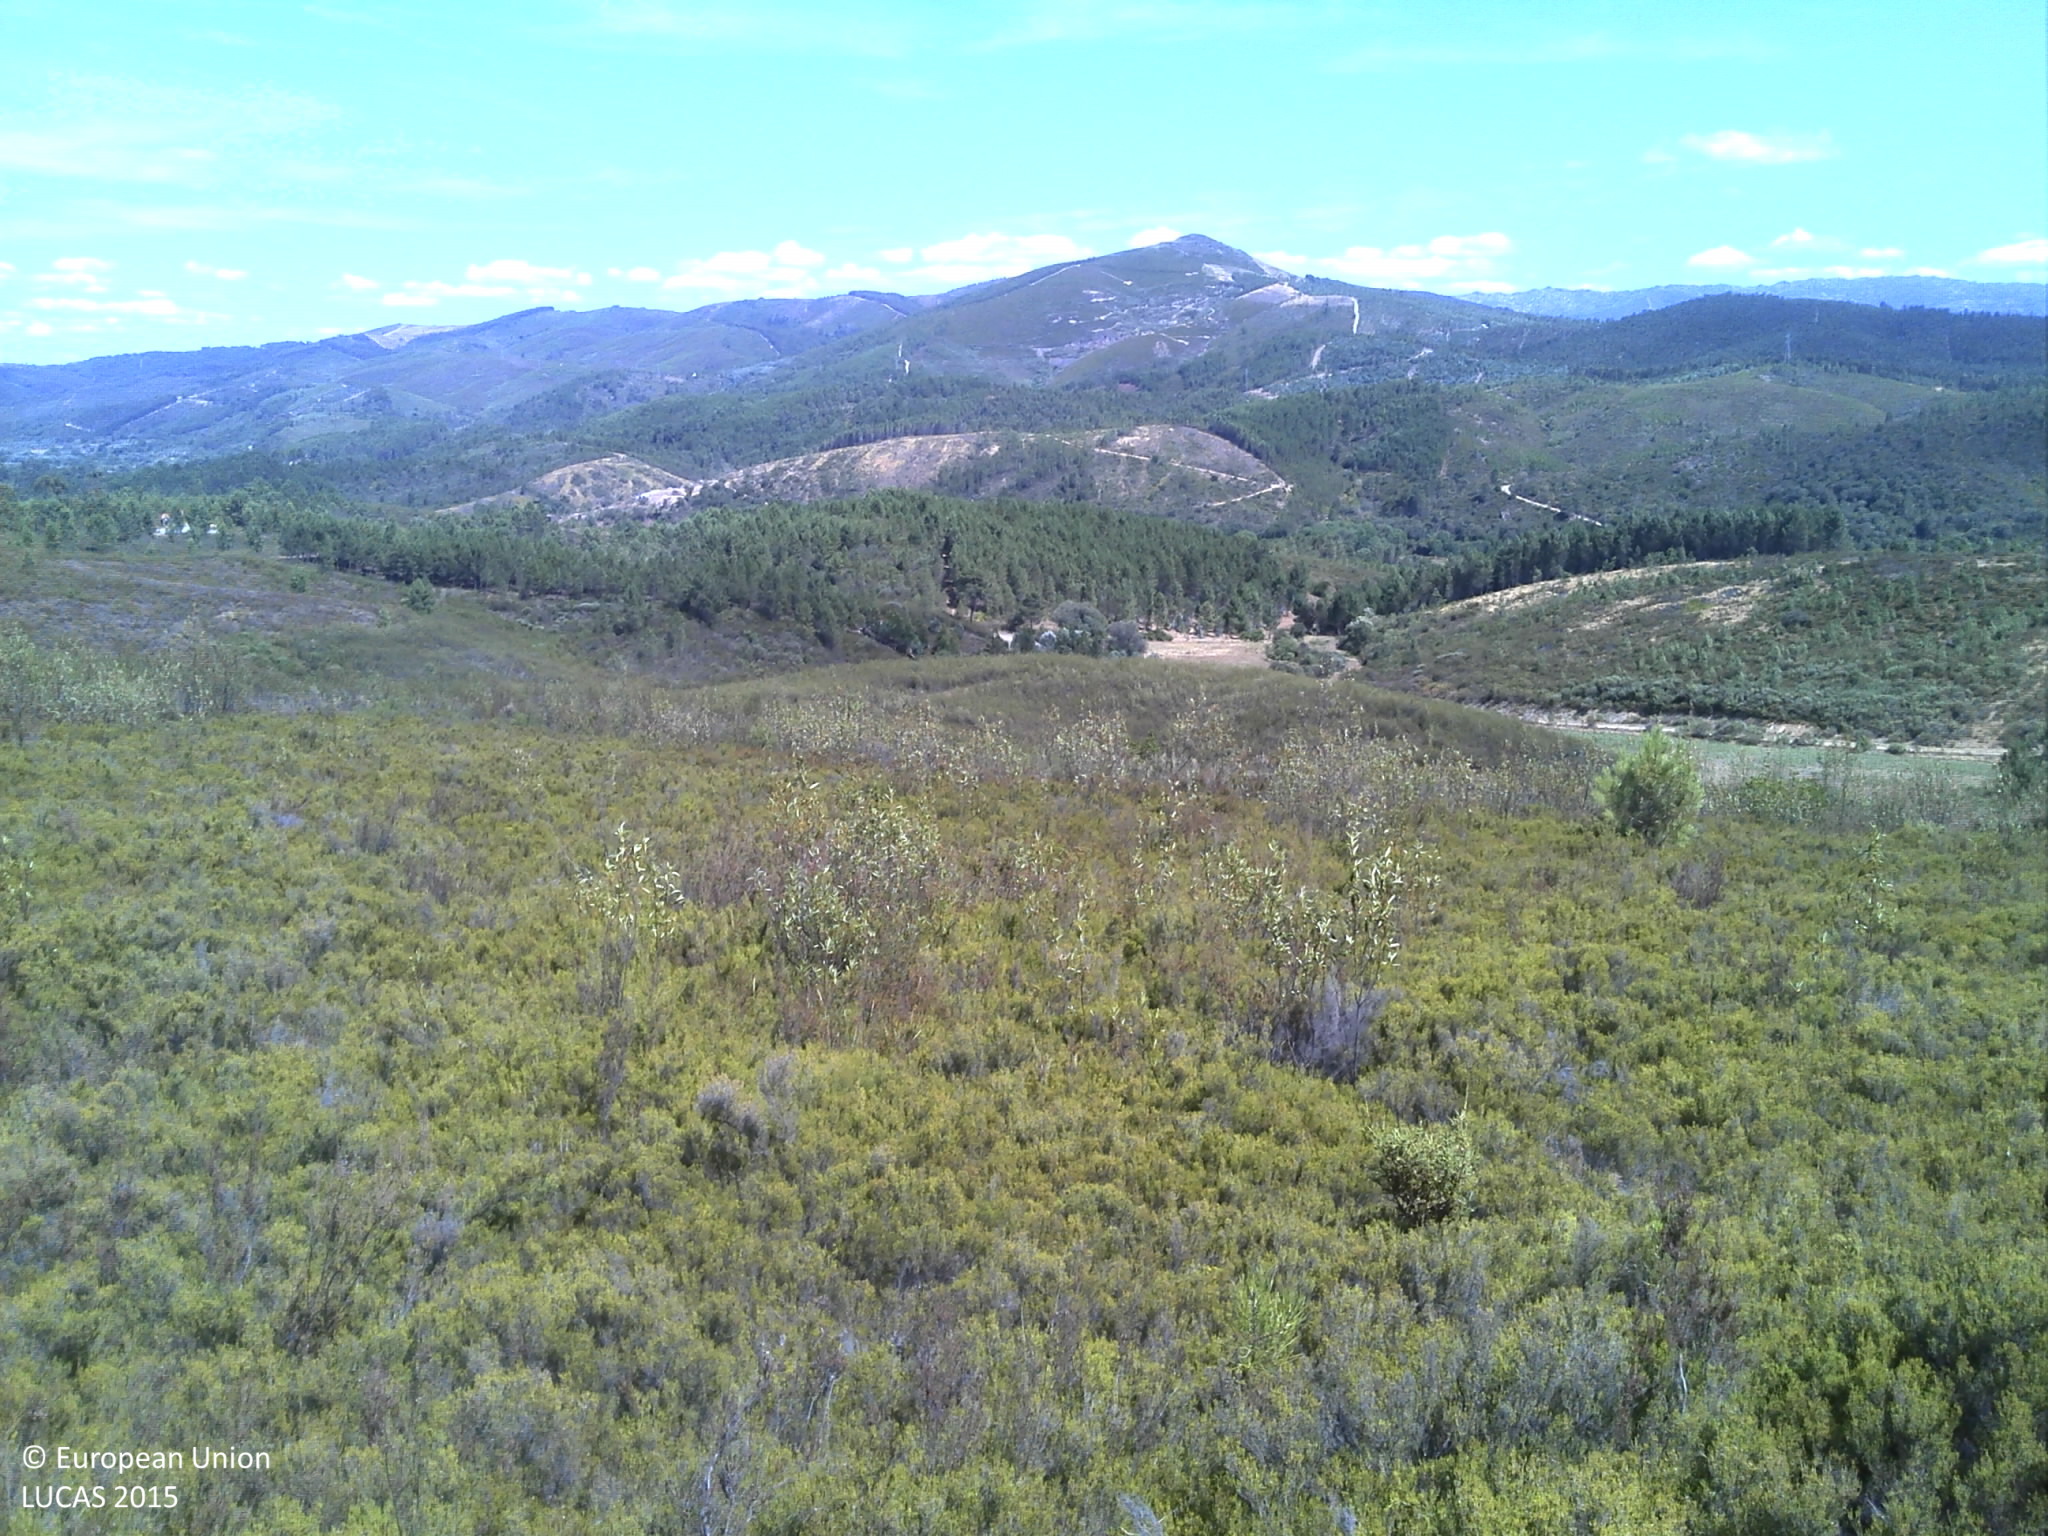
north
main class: Shrubland
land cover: Shrubland without tree cover
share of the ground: > 75 %
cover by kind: shrubs 80 %, unconsolidated bare surface 20 %
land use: Abandoned areas
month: July
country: PT
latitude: 40.1687
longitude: -7.6399
